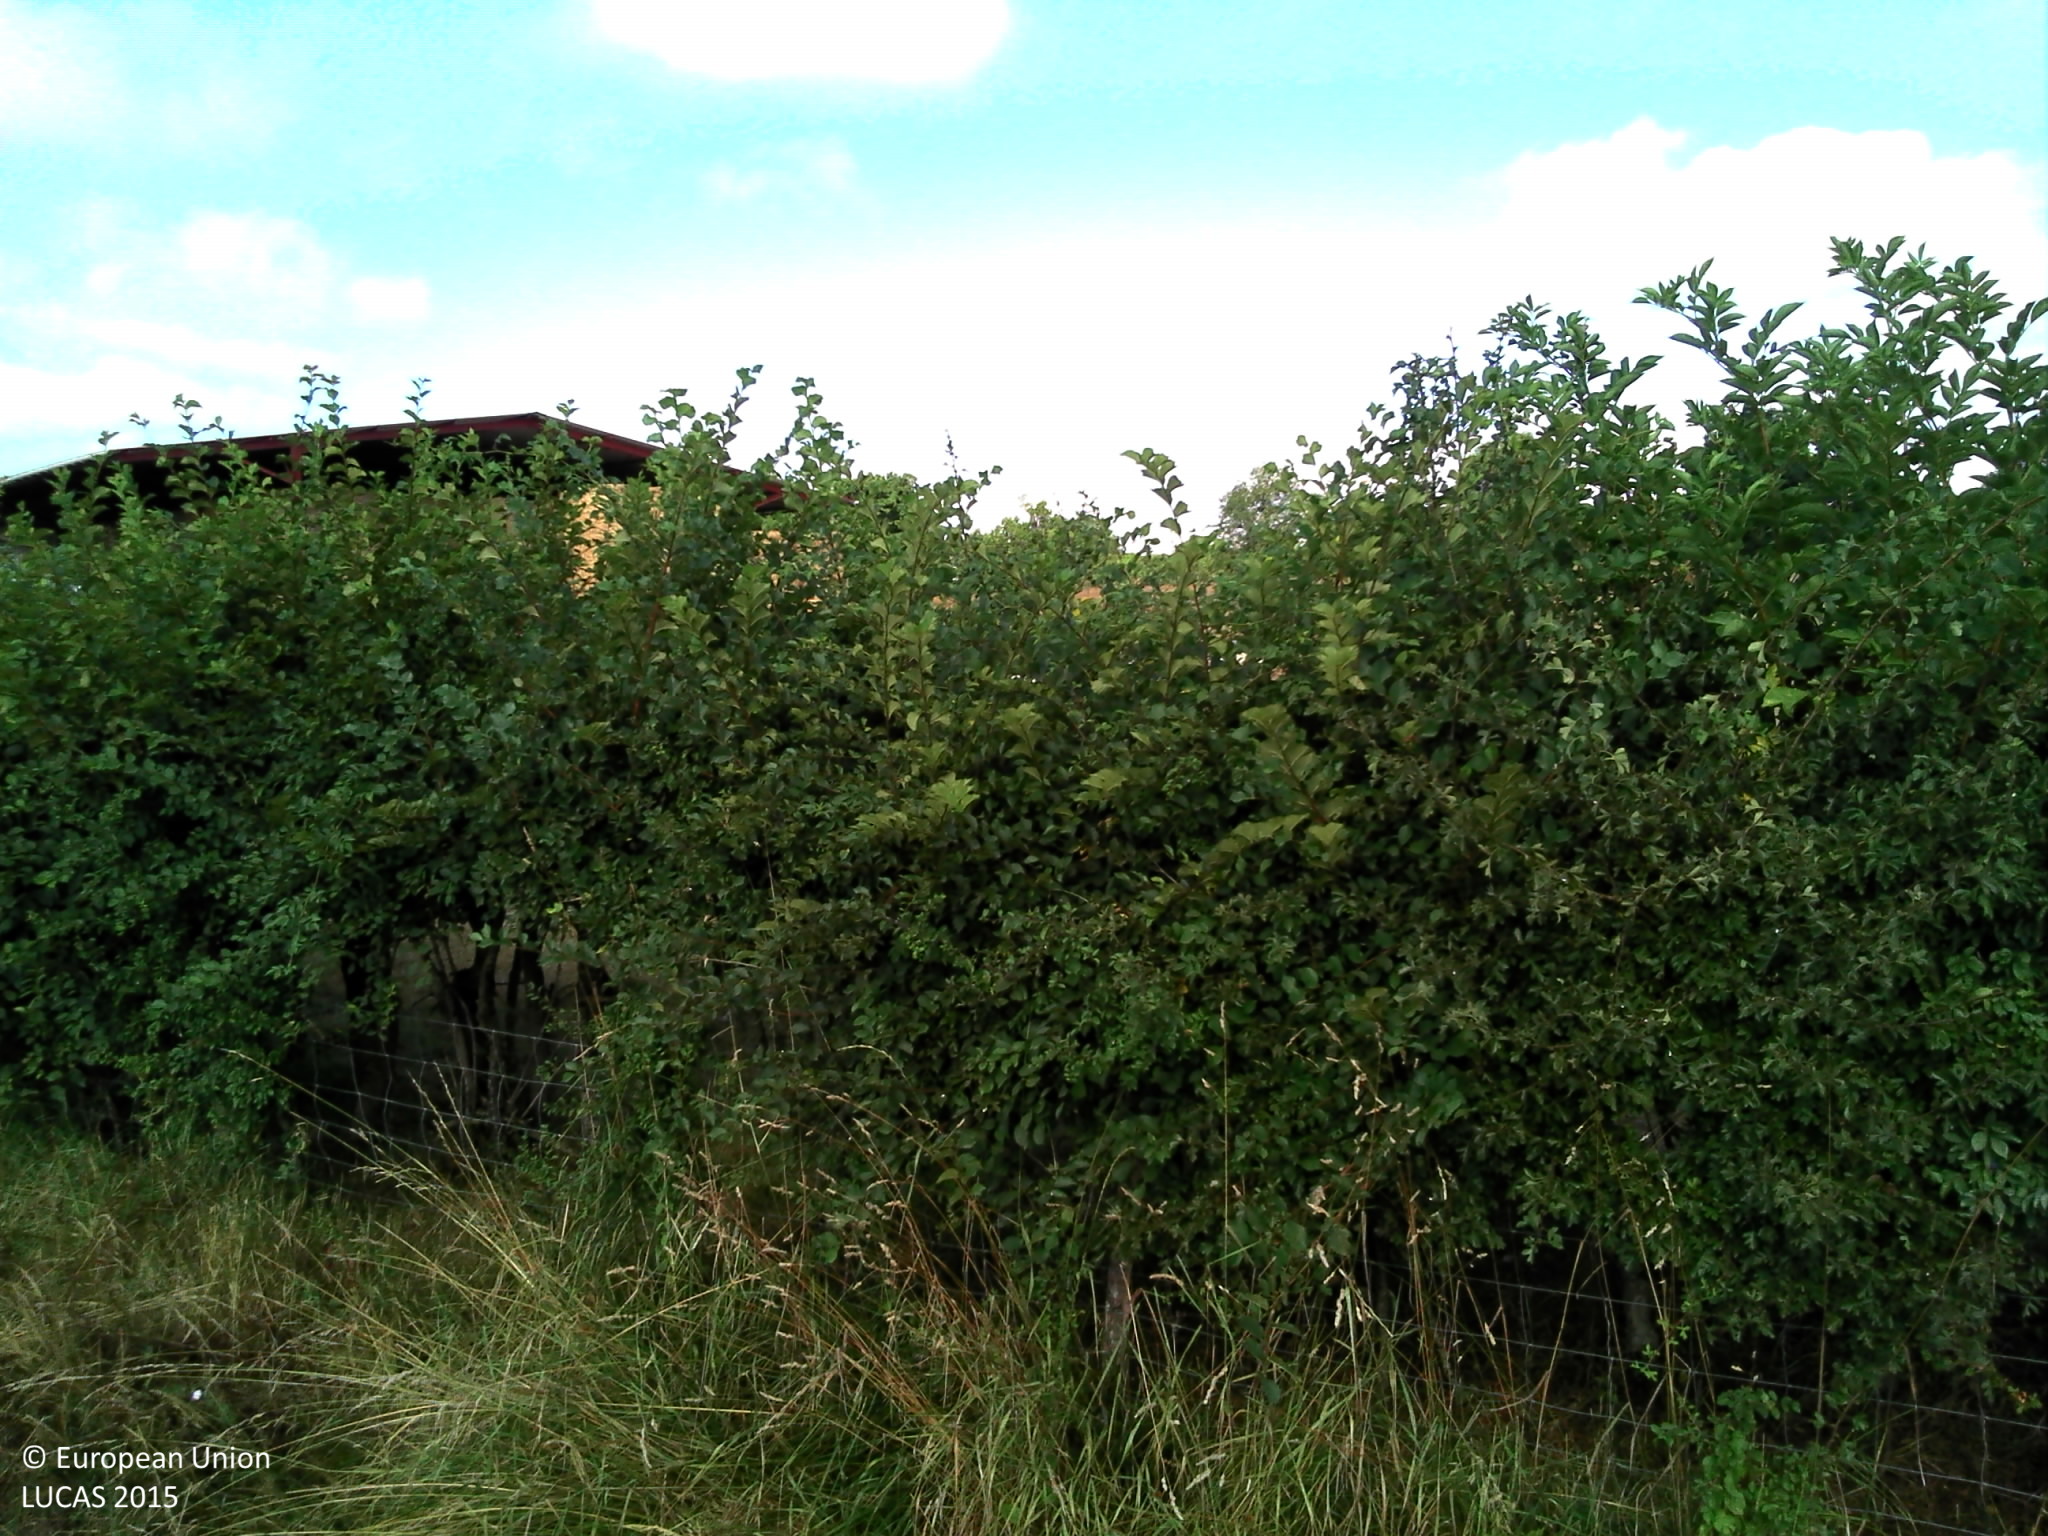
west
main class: Grassland
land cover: Grassland without tree/shrub cover
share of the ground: > 75 %
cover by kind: herbaceous plants 100 %
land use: Agriculture (excluding fallow land and kitchen gardens)
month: July
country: FR
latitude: 46.2183
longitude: 0.5075
